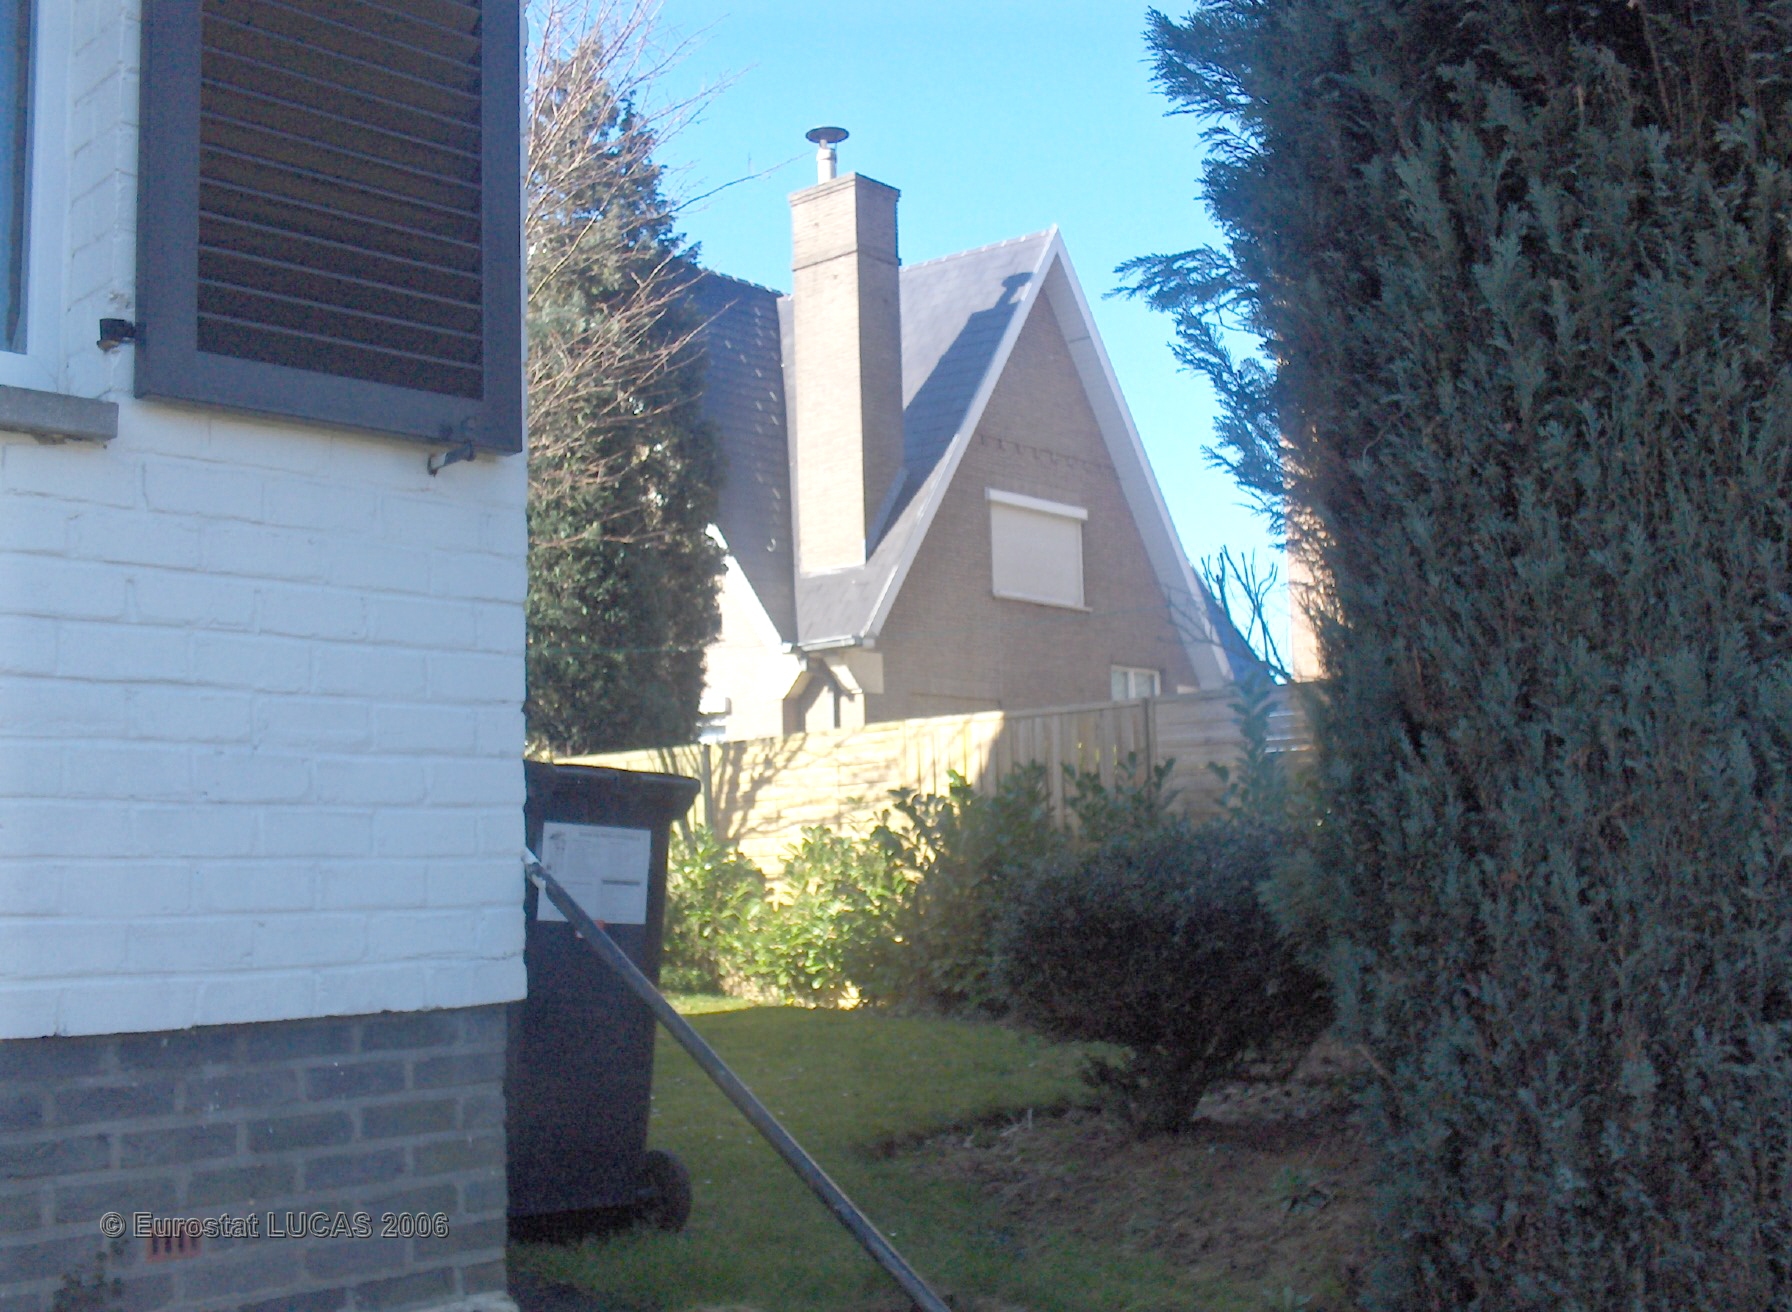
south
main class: Grassland
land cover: Grassland without tree/shrub cover
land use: Residential
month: March
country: BE
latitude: 50.8432
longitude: 4.4712
